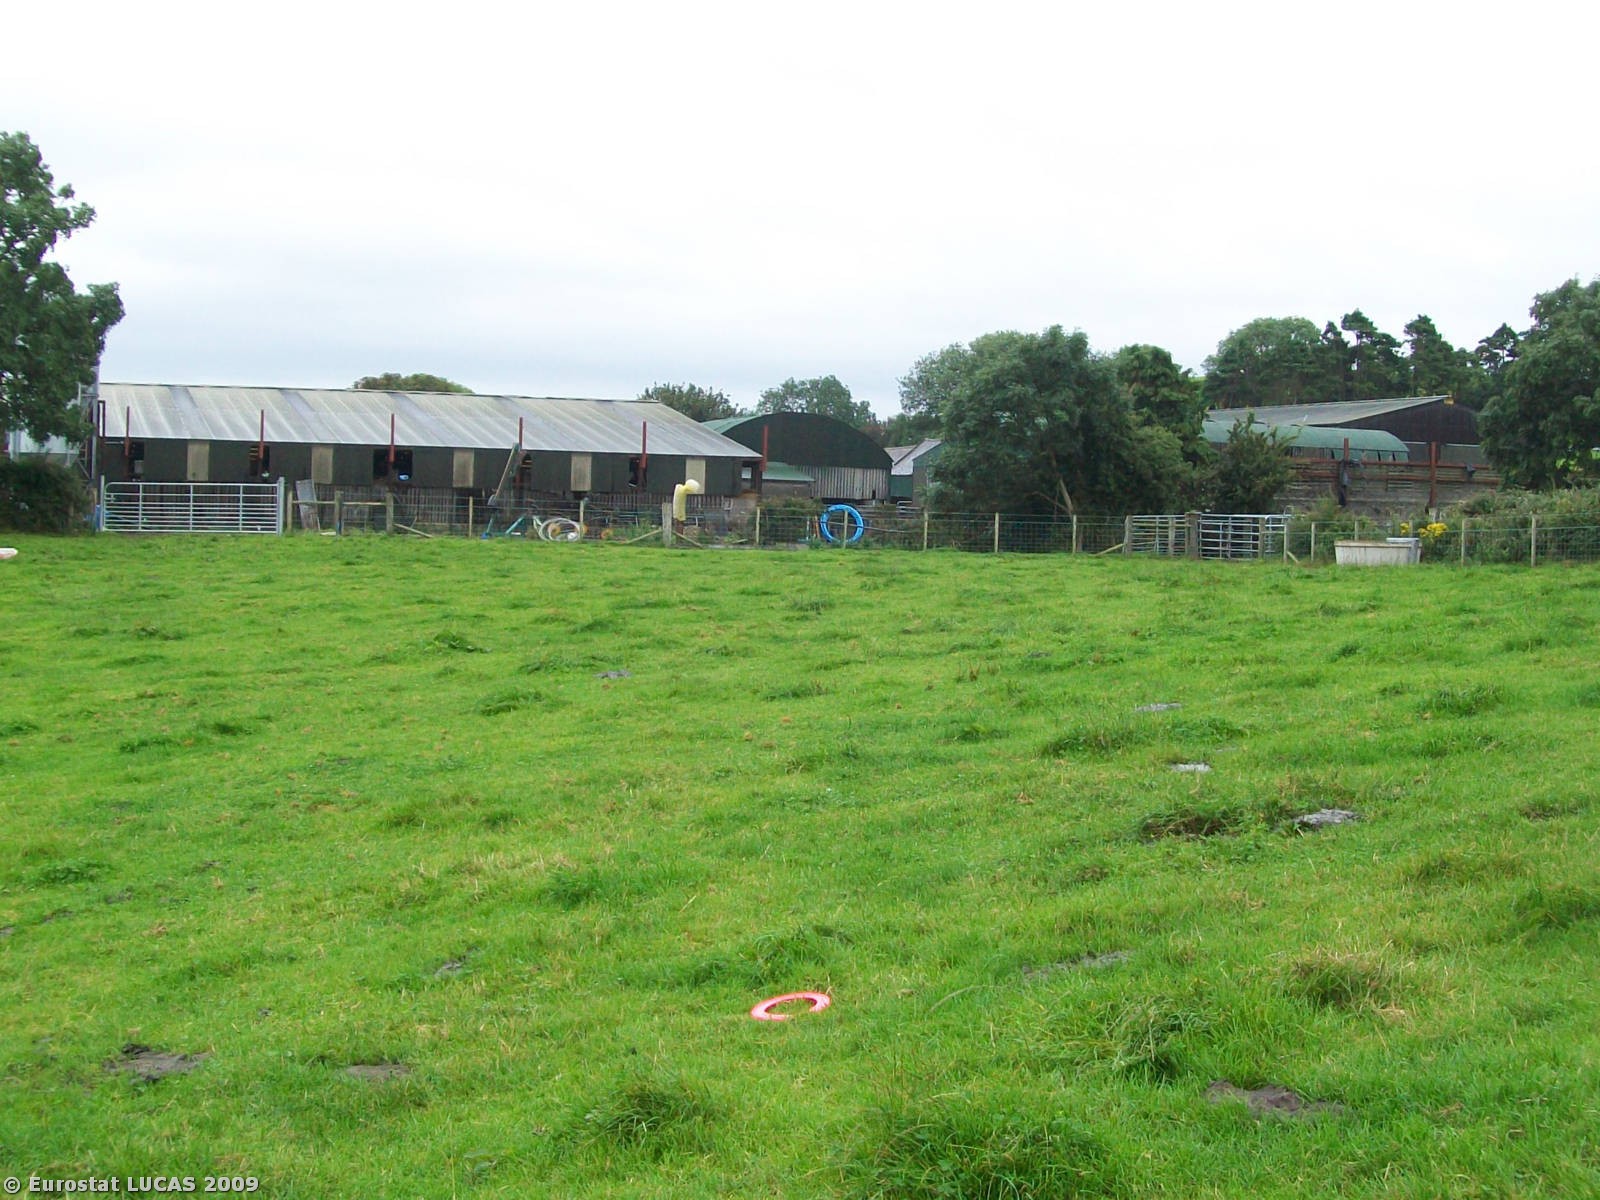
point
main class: Grassland
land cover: Grassland without tree/shrub cover
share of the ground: > 75 %
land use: Agriculture (excluding fallow land and kitchen gardens)
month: August
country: GB
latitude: 54.3492
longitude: -5.5602
